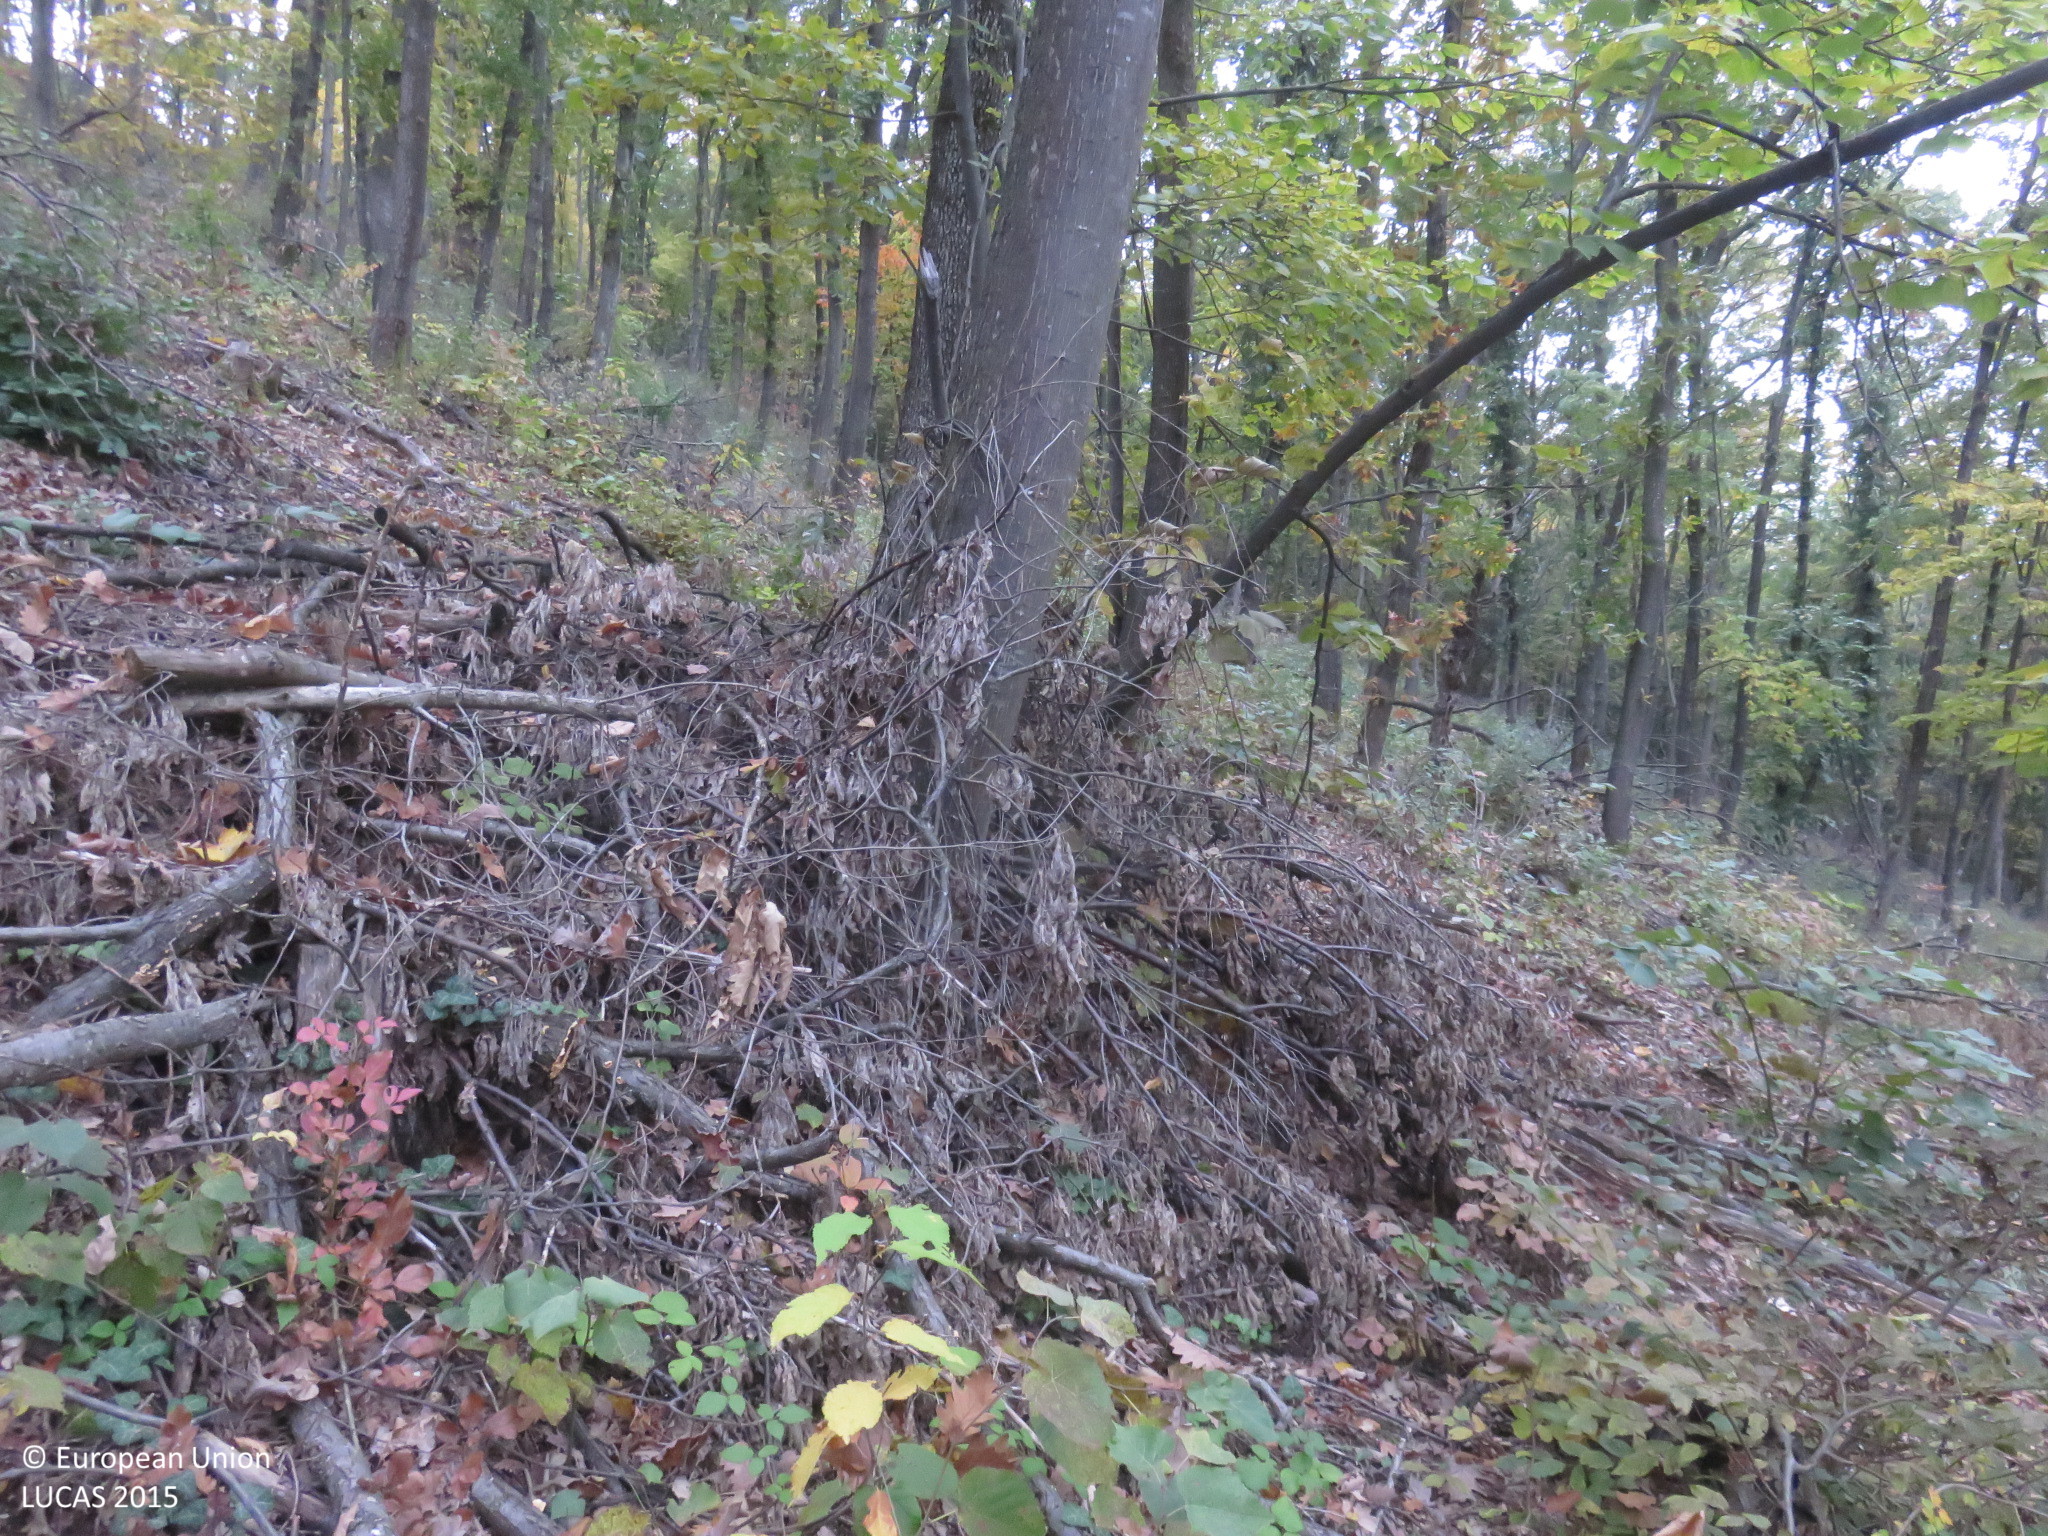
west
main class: Woodland
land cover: Broadleaved woodland
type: mesophytic deciduous forest
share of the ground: > 75 %
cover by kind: broadleaved forest trees 80 %, shrubs 10 %, herbaceous plants 10 %
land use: Forestry
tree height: > 5 m
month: October
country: BG
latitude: 42.9443
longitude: 24.9800
